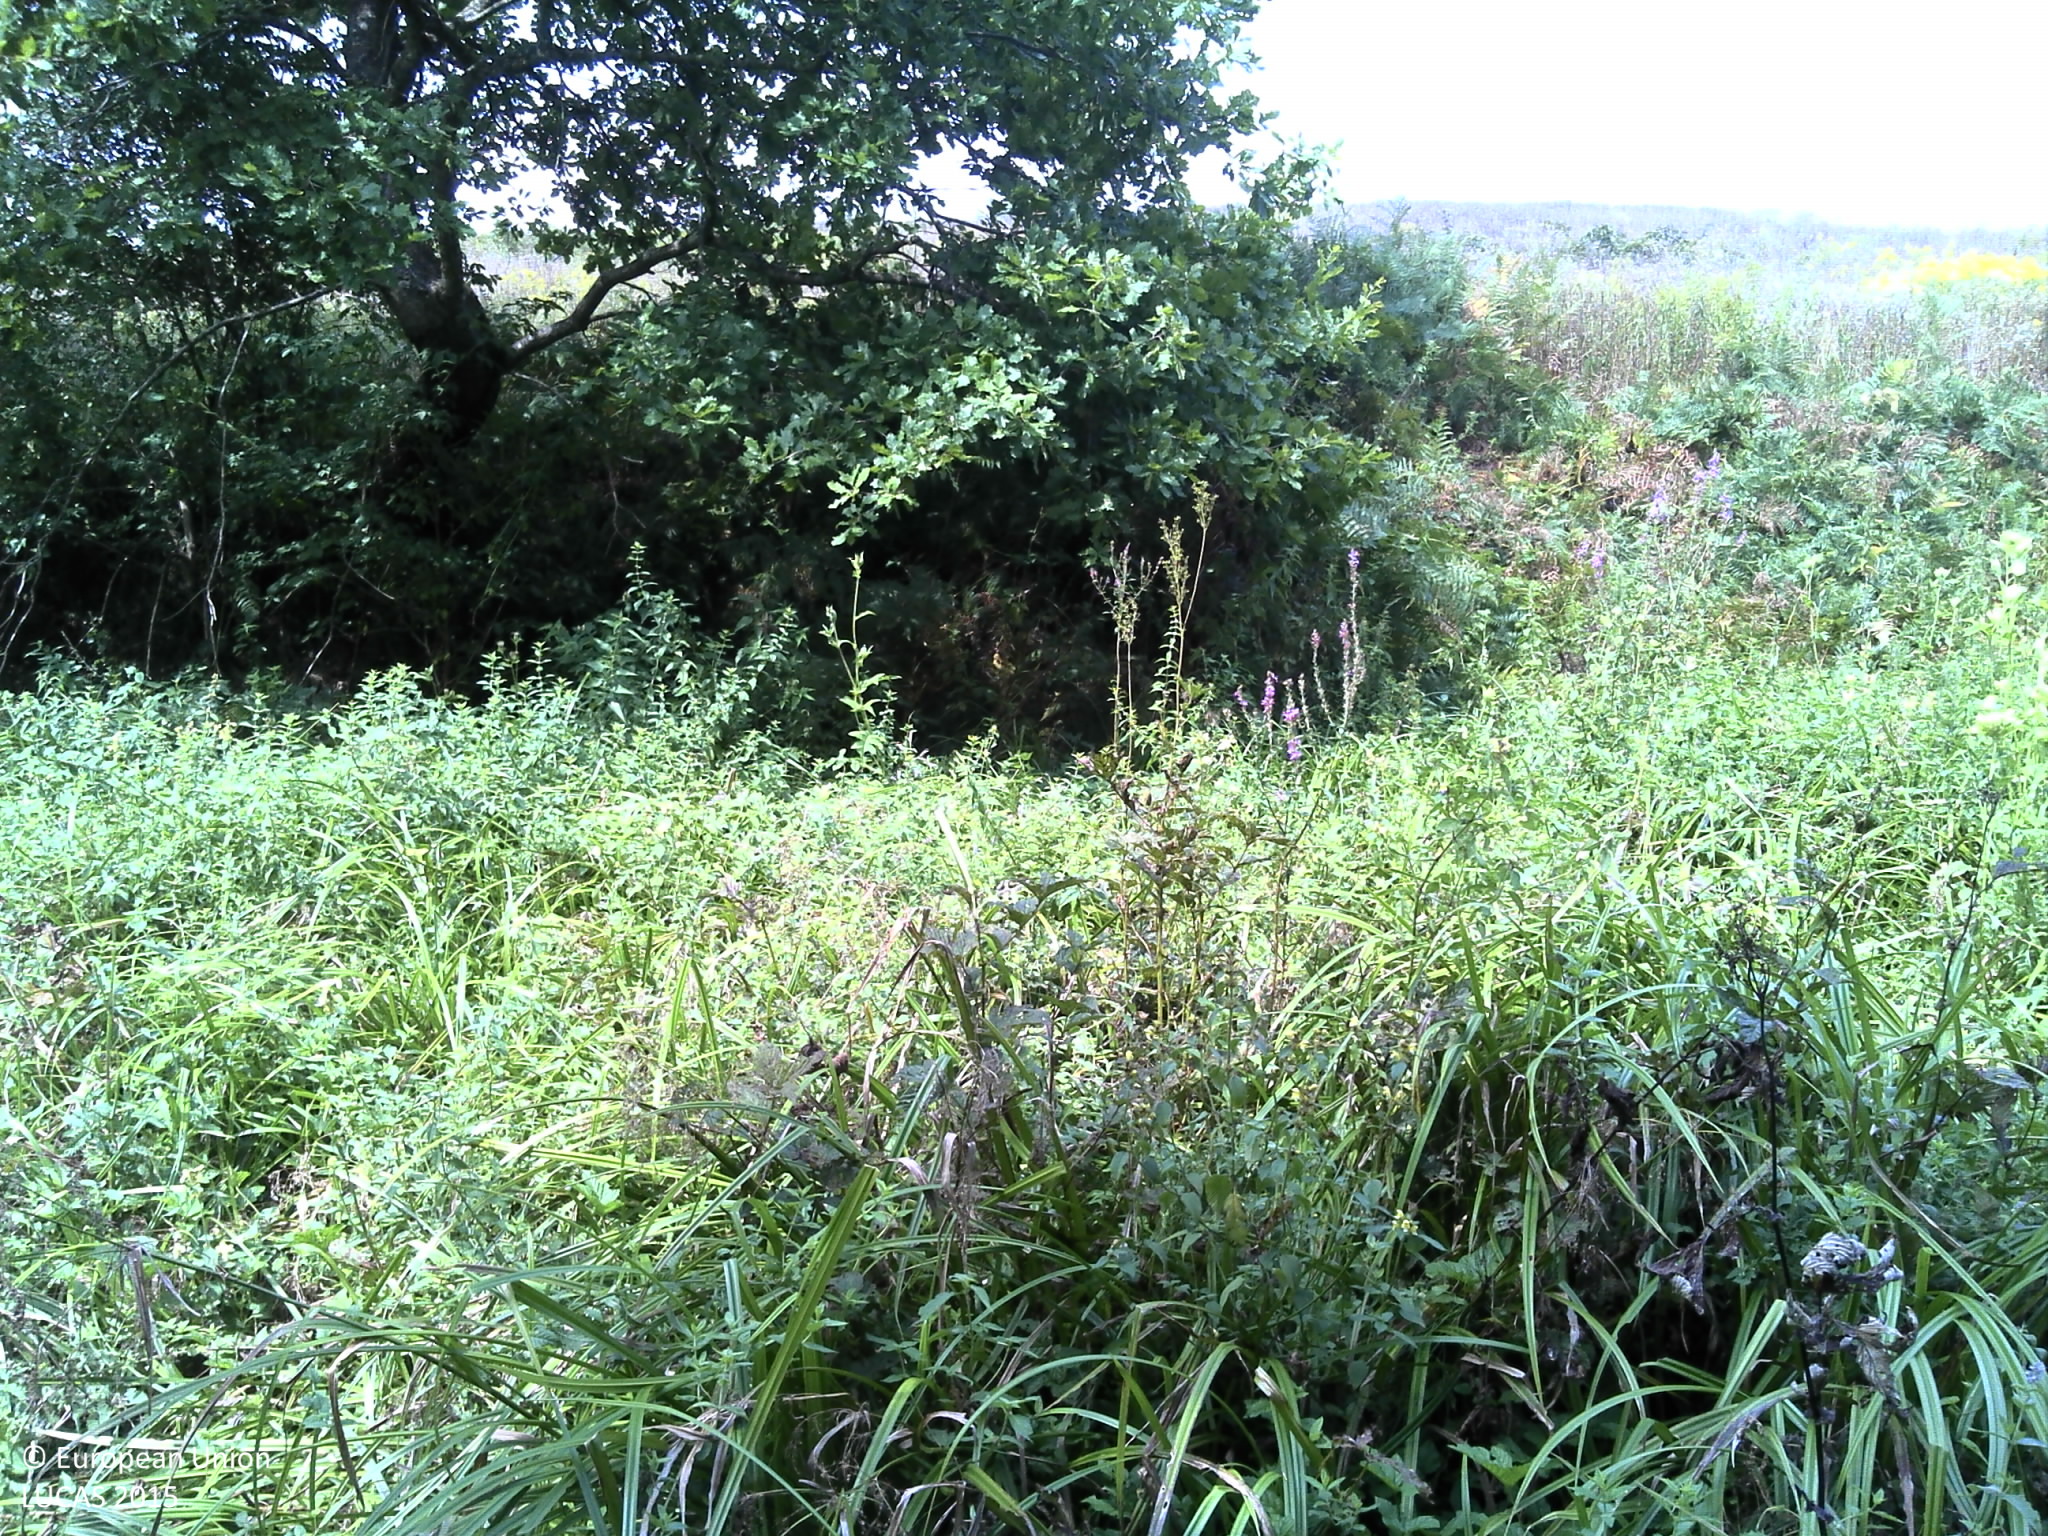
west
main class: Grassland
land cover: Spontaneously vegetated surfaces
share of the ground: > 75 %
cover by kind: herbaceous plants 100 %
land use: Fallow land
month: August
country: HR
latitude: 45.2931
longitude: 16.0788
